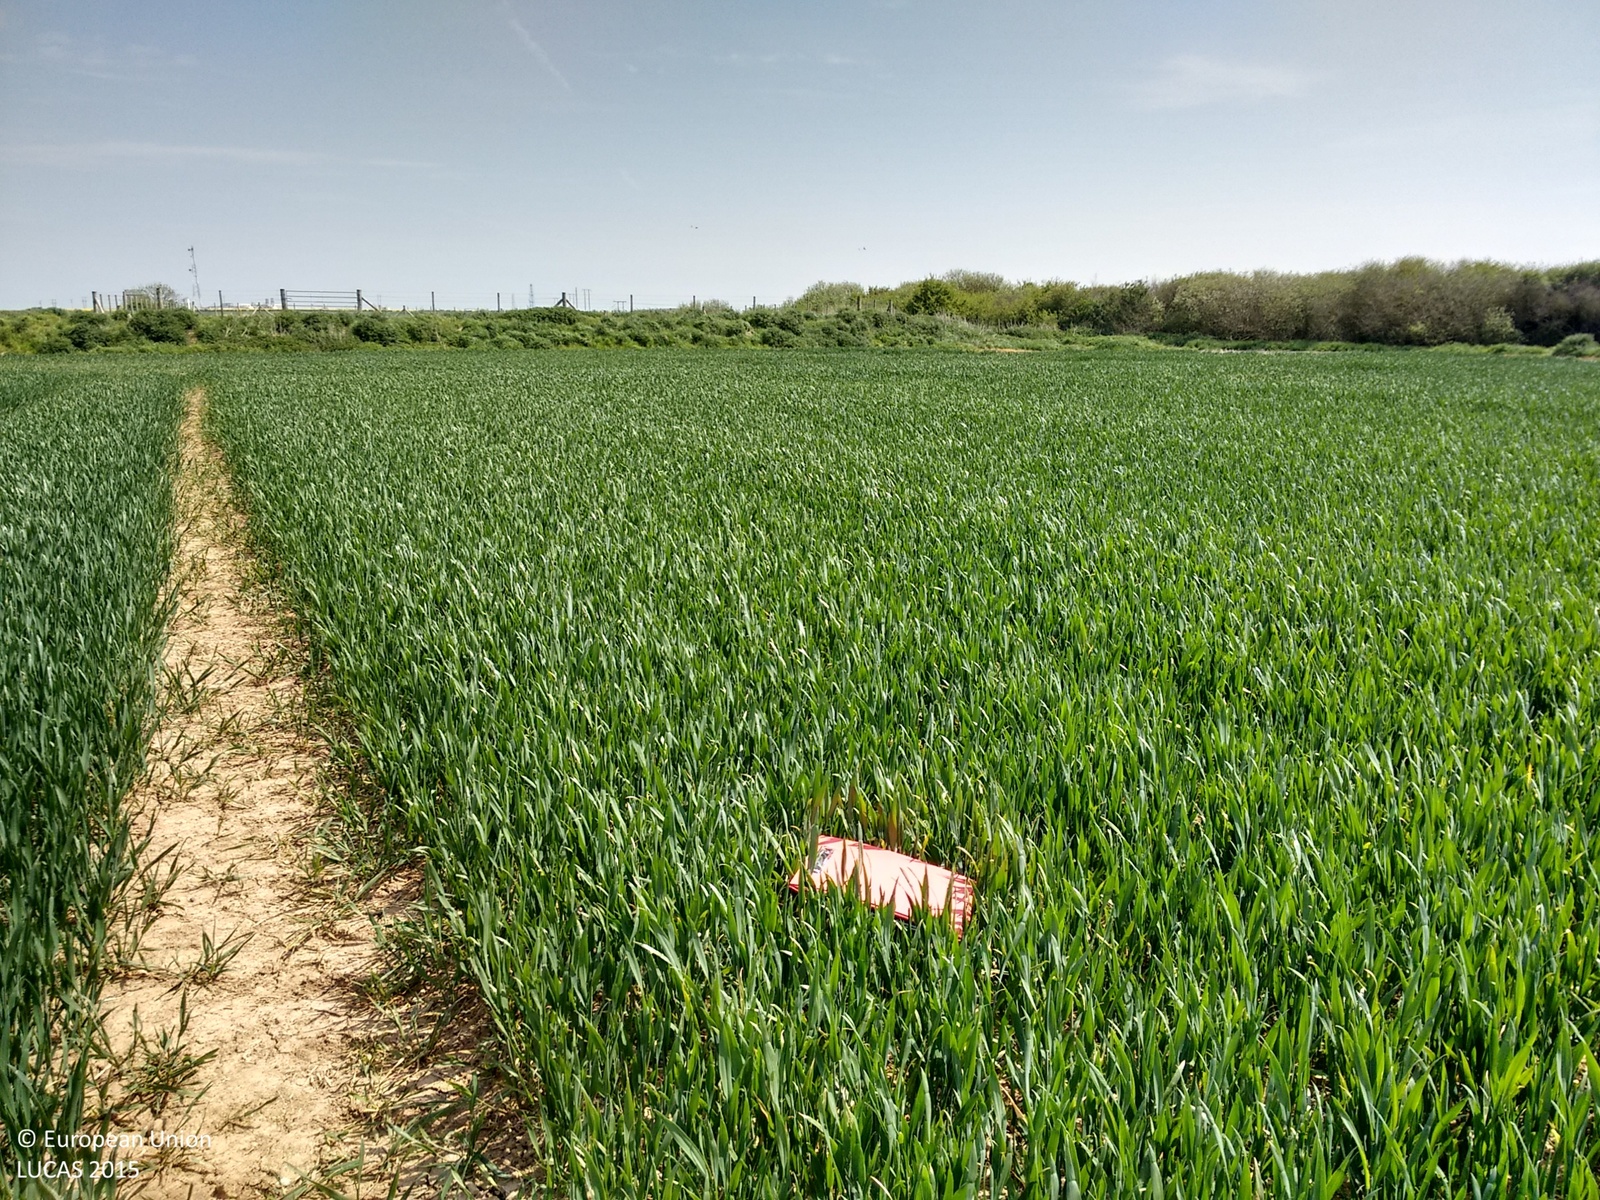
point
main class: Cropland
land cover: Common wheat
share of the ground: > 75 %
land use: Agriculture (excluding fallow land and kitchen gardens)
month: May
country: GB
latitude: 53.6646
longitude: 0.0868
